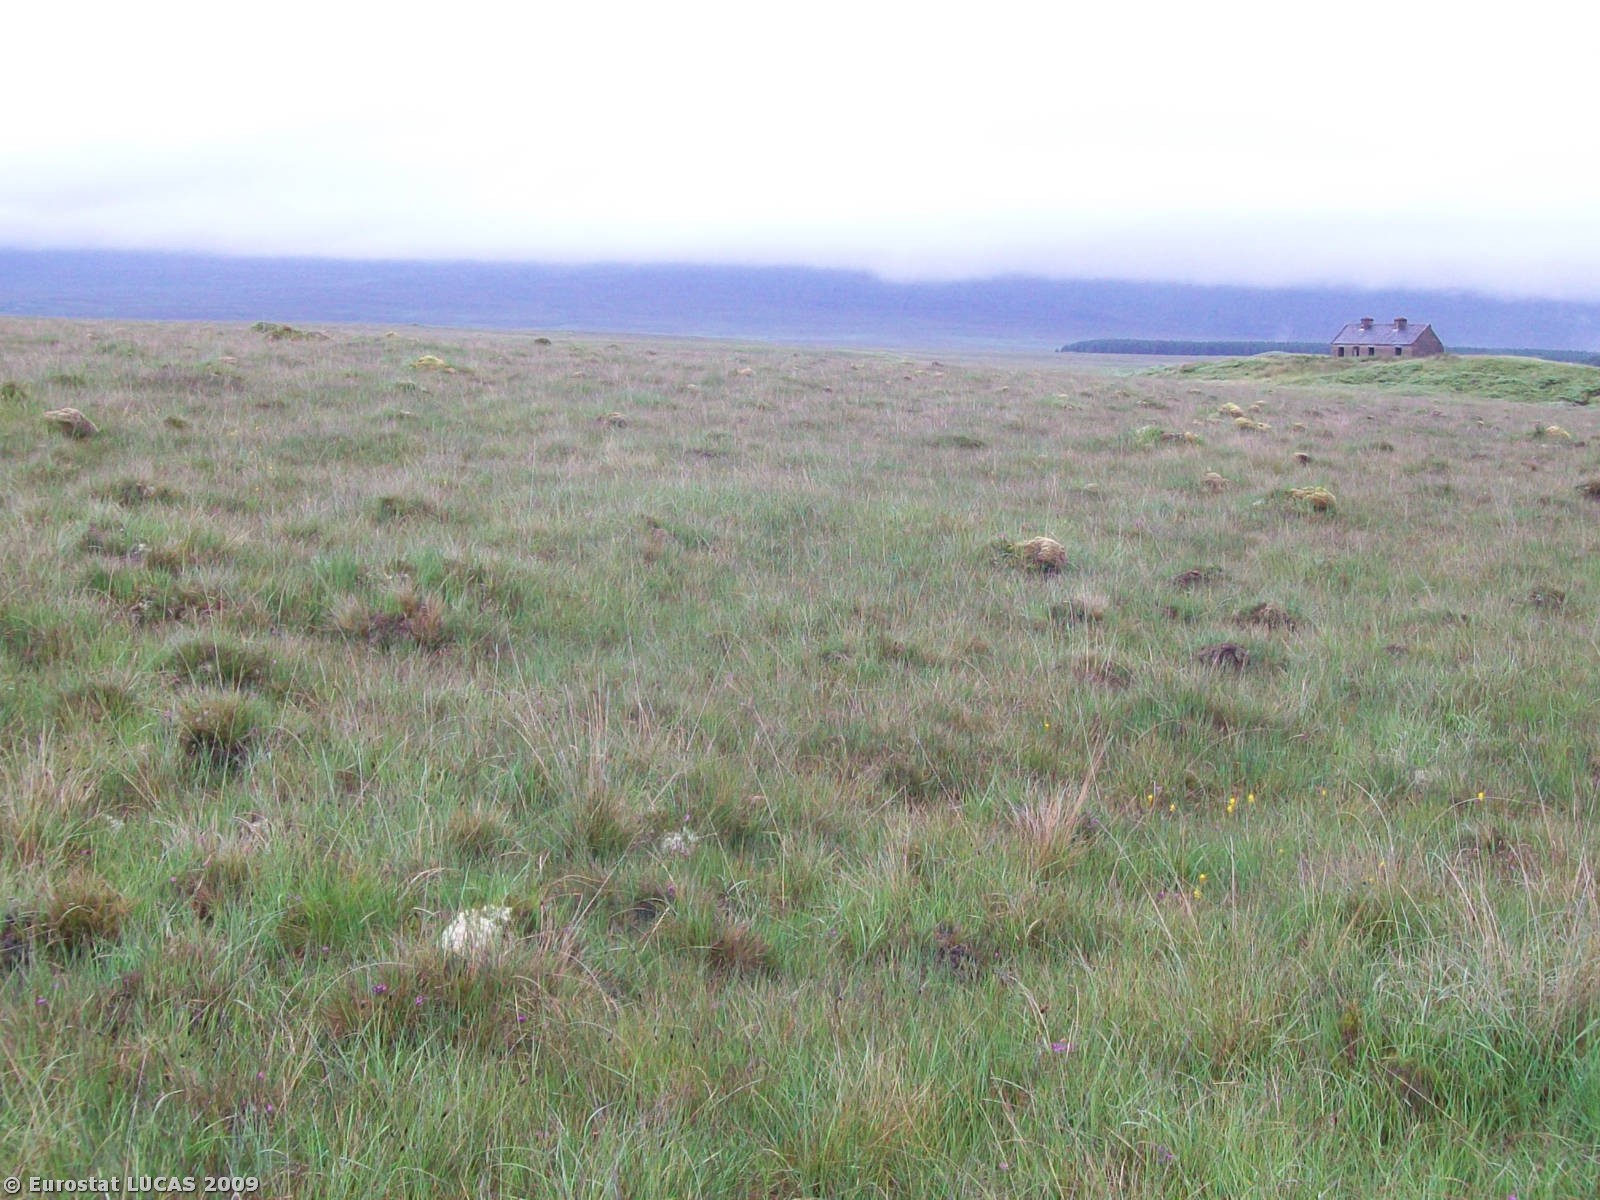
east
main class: Wetlands
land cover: Peatbogs
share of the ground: > 75 %
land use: Unused
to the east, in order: Peatbogs; Grassland without tree/shrub cover; Rivers and streams; Grassland without tree/shrub cover; Shrubland without tree cover
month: July
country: IE
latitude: 53.9955
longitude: -9.7522
